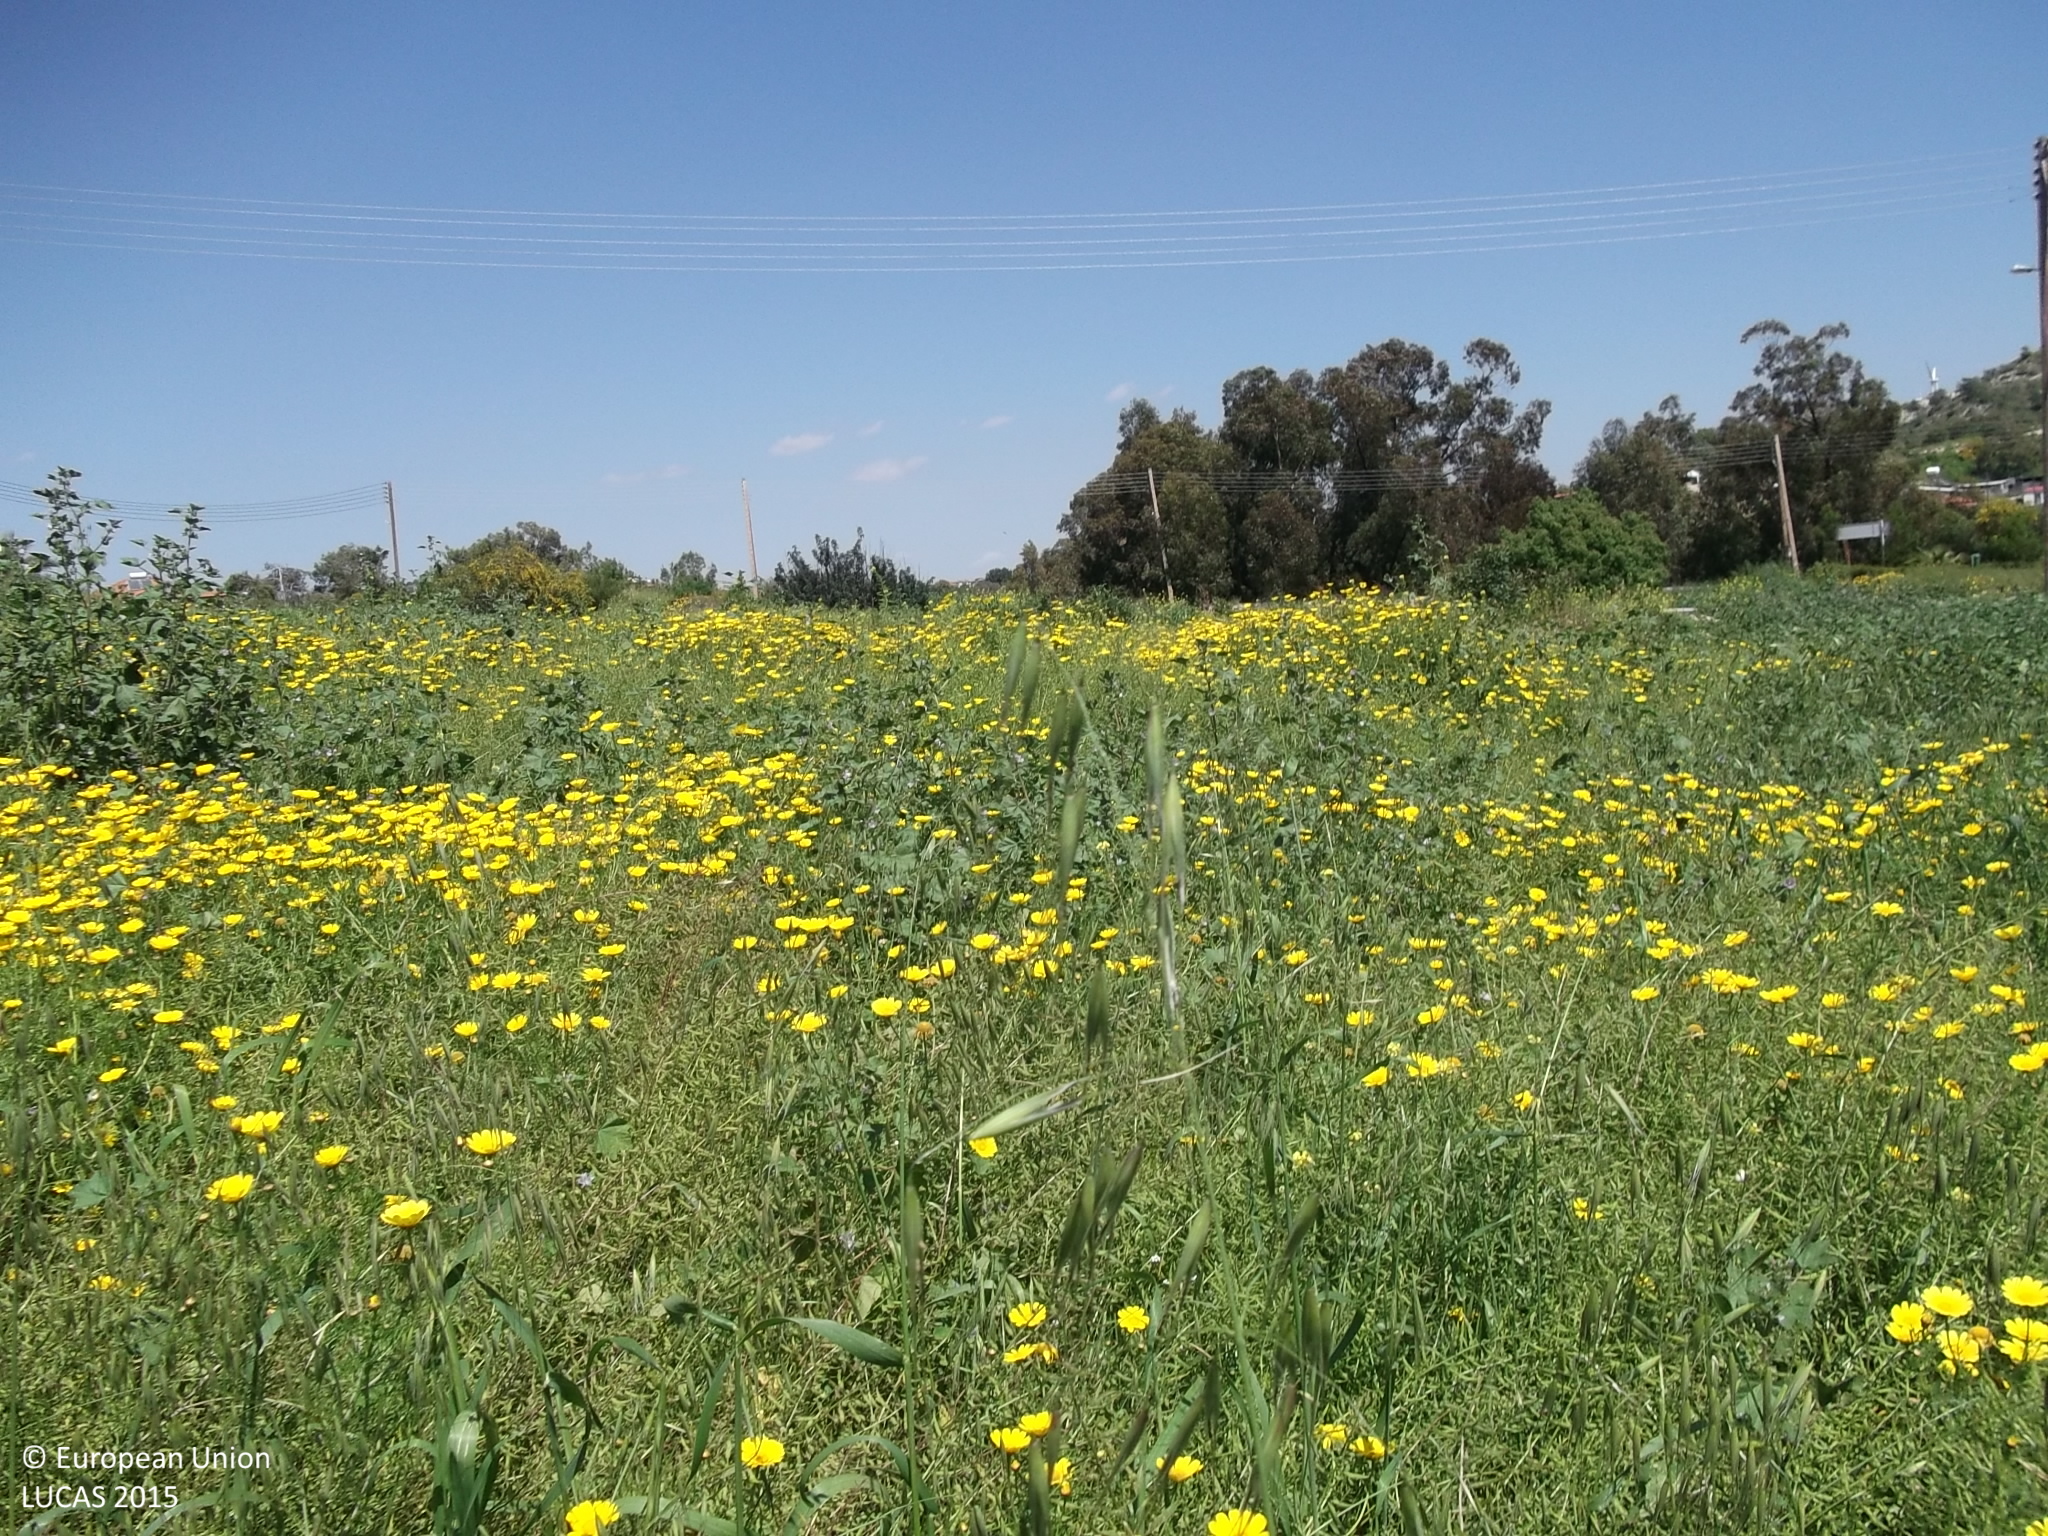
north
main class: Grassland
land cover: Spontaneously vegetated surfaces
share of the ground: > 75 %
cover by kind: herbaceous plants 100 %
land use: Residential
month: April
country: CY
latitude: 34.8534
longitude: 33.4961
